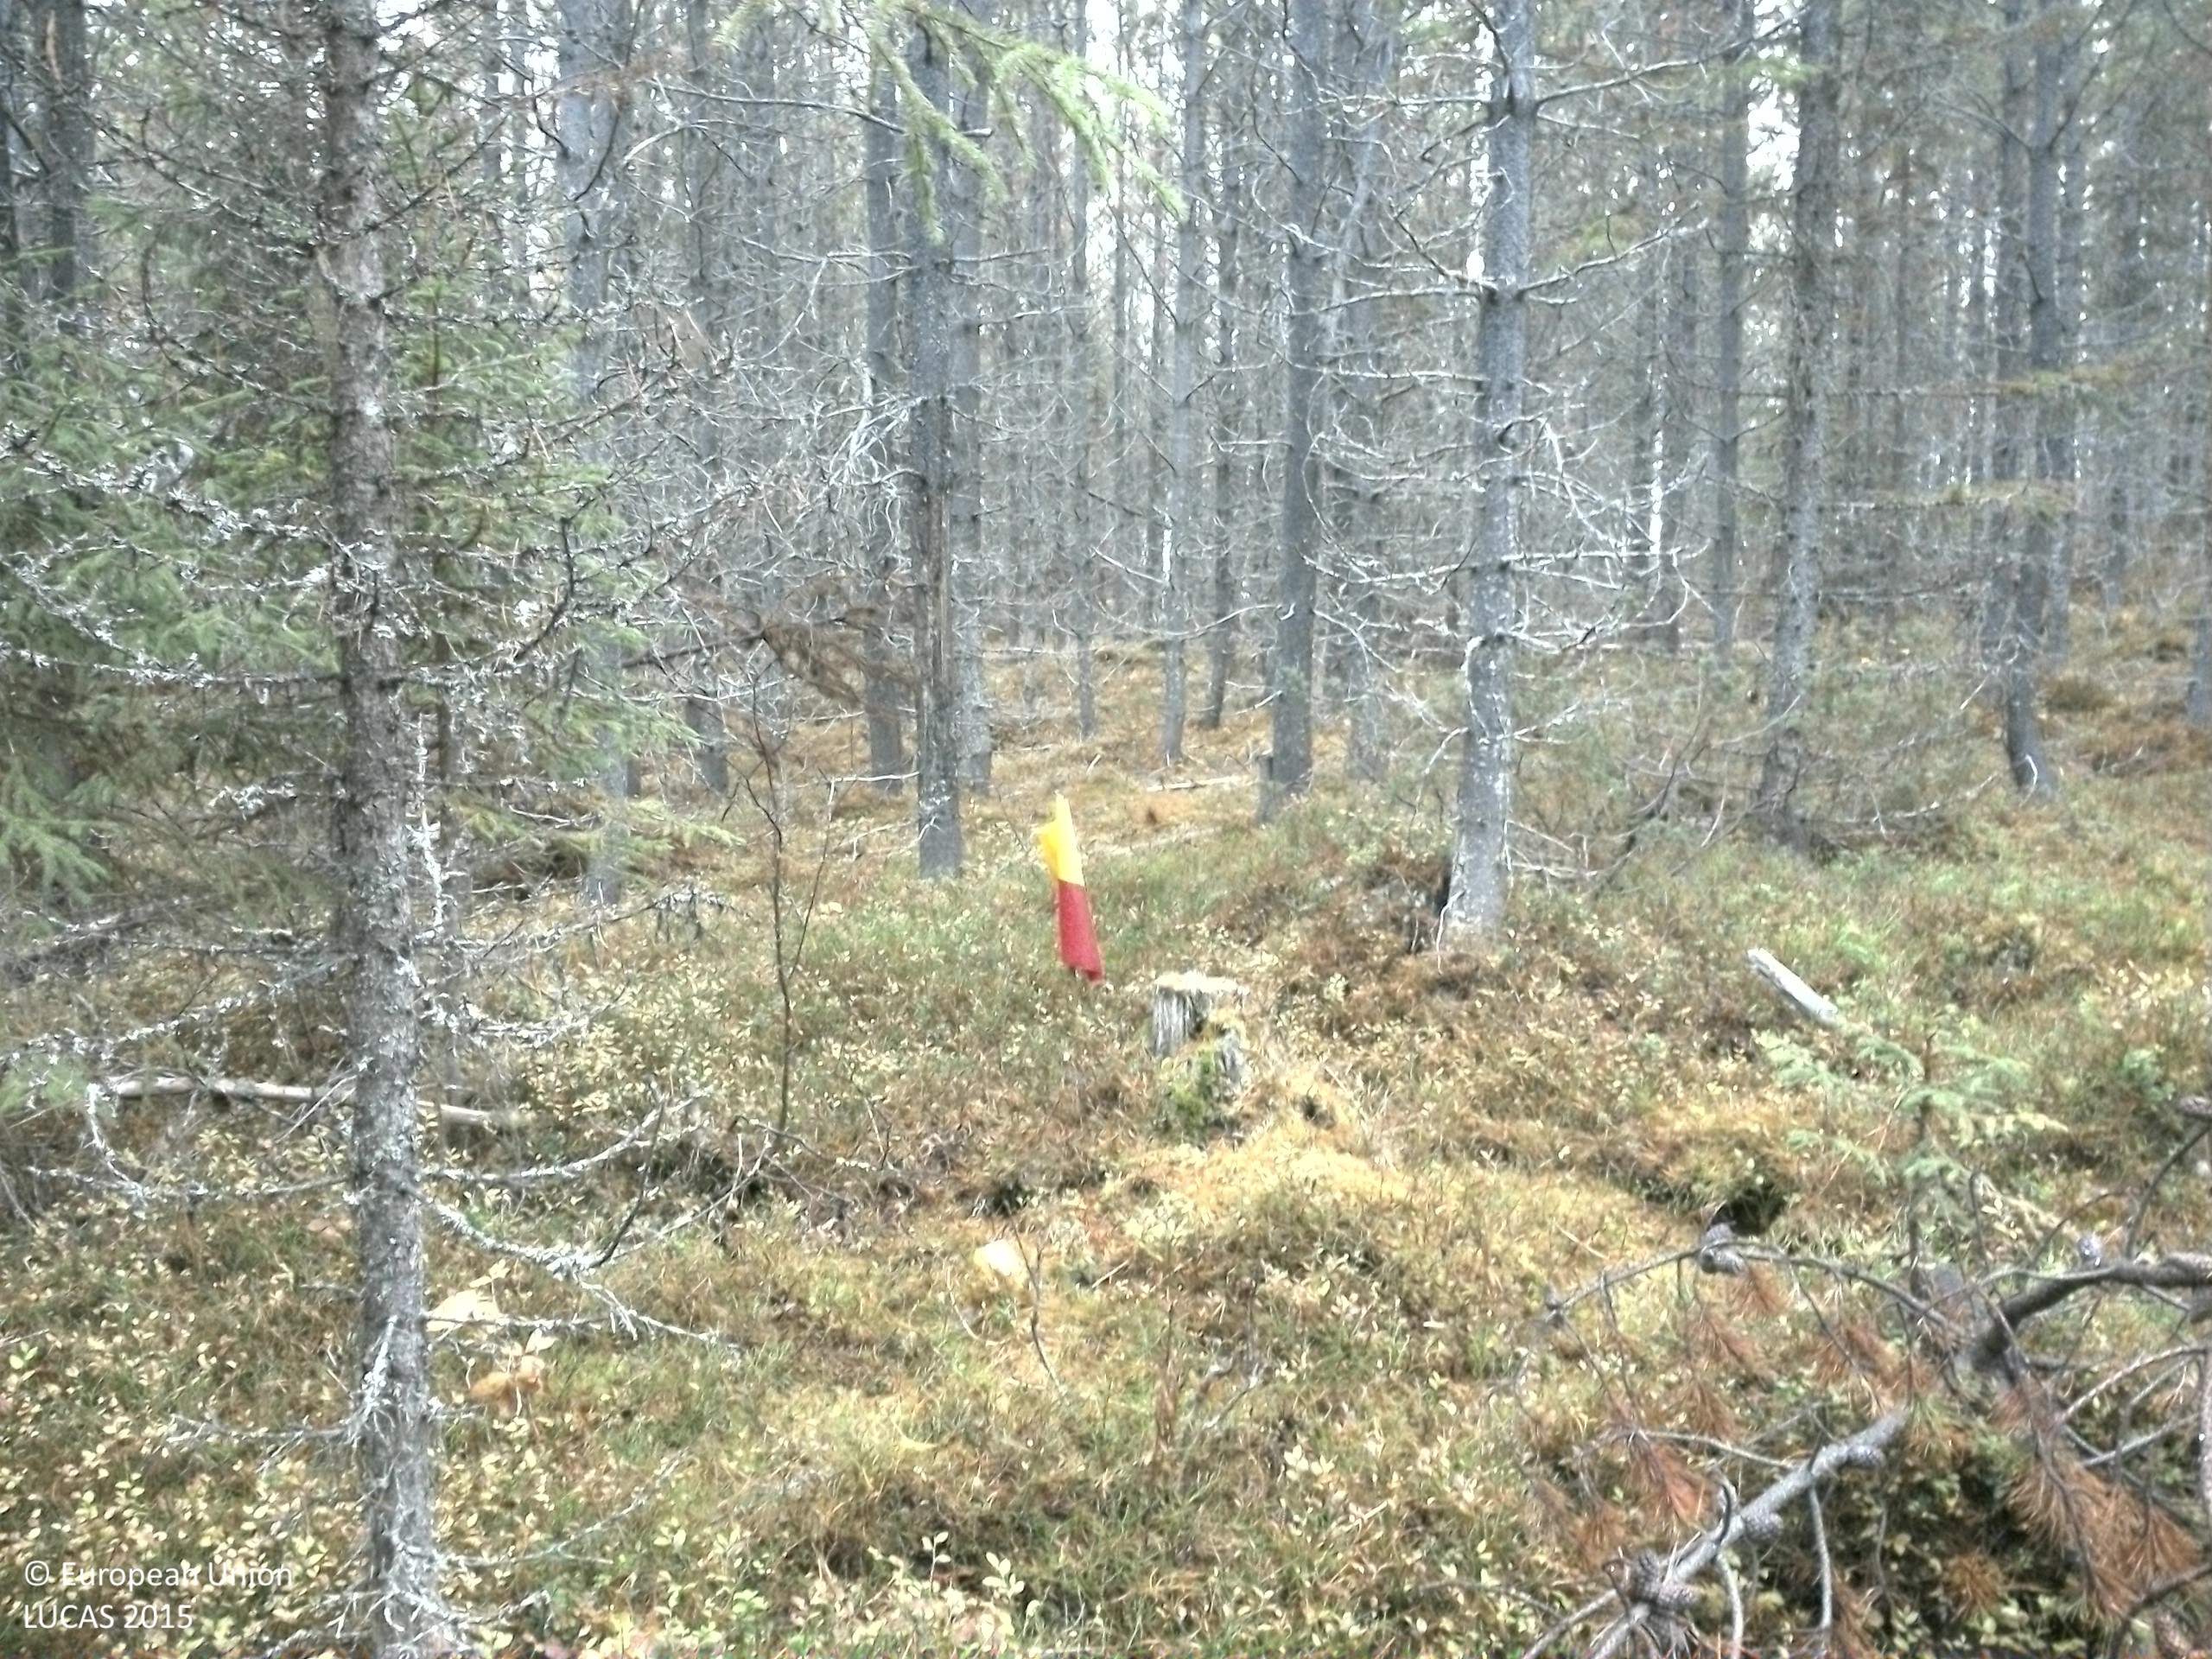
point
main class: Woodland
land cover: Pine dominated coniferous woodland
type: exotic forest
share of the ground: 25 - 50 %
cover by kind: coniferous forest trees 45 %, shrubs 35 %, lichens and mosses 15 %, unconsolidated bare surface 5 %
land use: Forestry
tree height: > 5 m
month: October
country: SE
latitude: 64.3046
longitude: 15.4491
